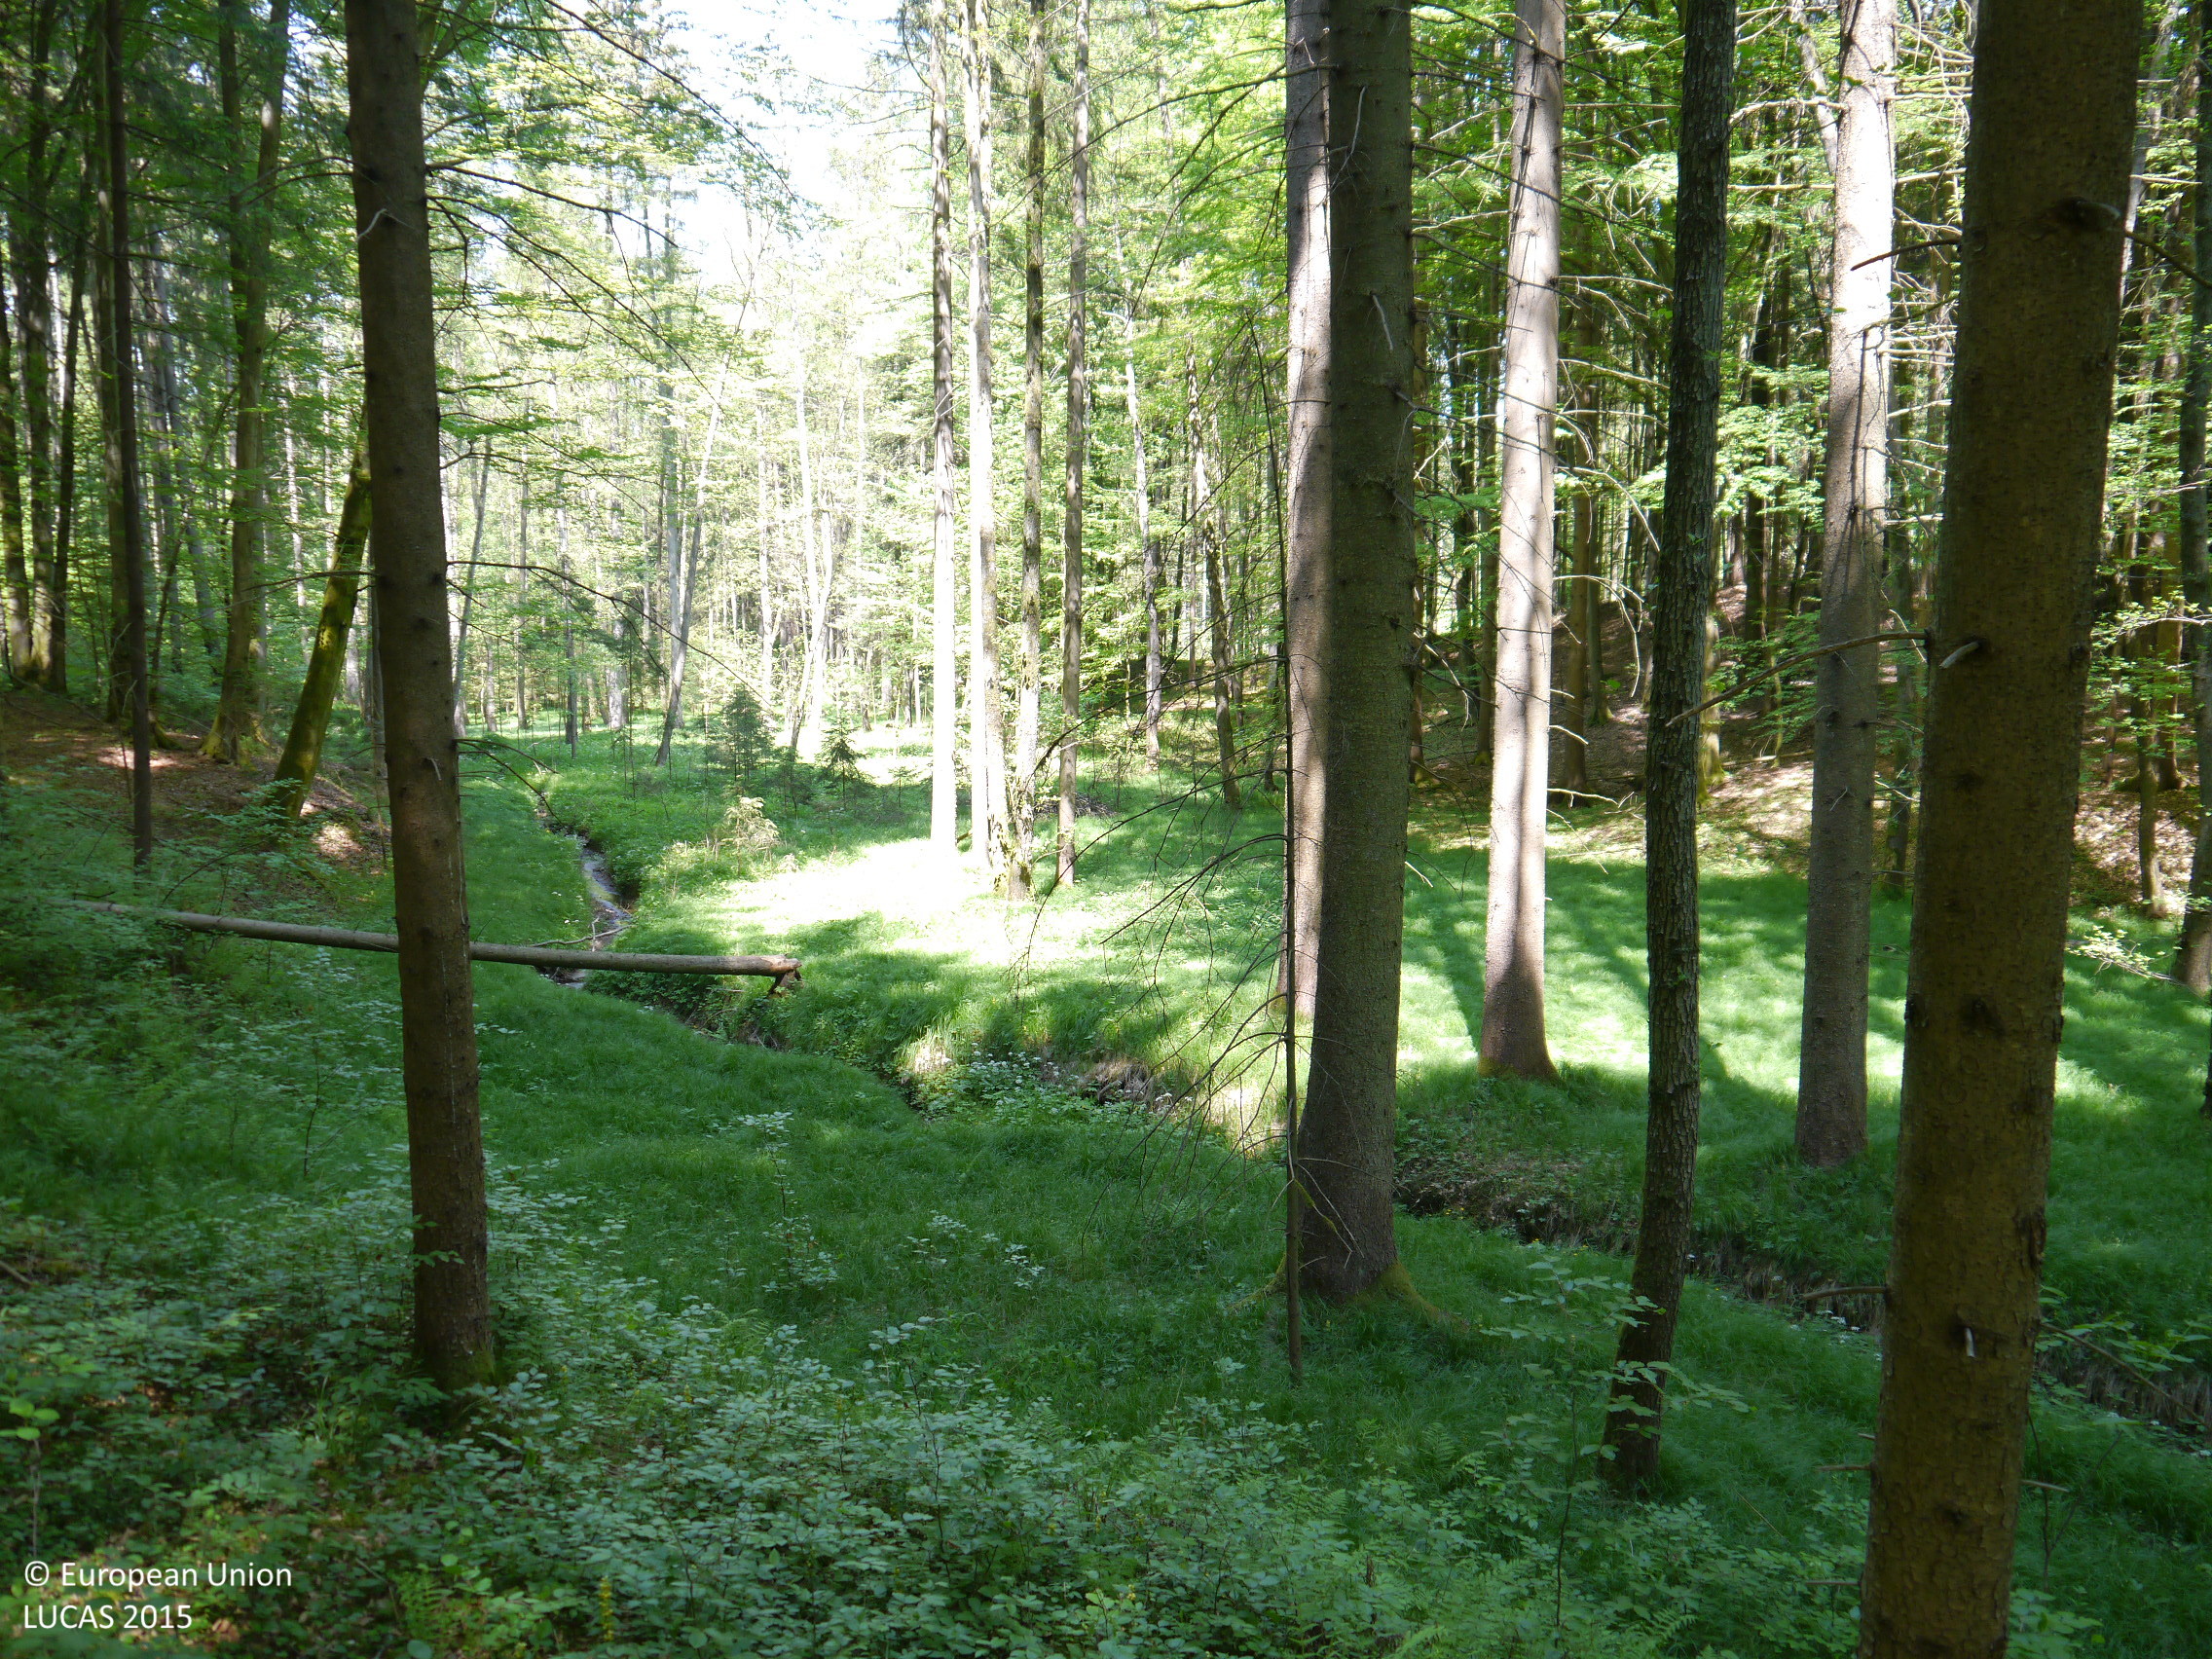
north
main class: Woodland
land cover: Spruce dominated mixed woodland
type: hemiboreal forest and nemoral coniferous forest and mixed broadleaved-coniferous forest
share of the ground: > 75 %
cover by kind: coniferous forest trees 50 %, broadleaved forest trees 40 %, herbaceous plants 10 %
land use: Forestry
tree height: > 5 m
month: May
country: AT
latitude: 46.9599
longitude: 15.2953
